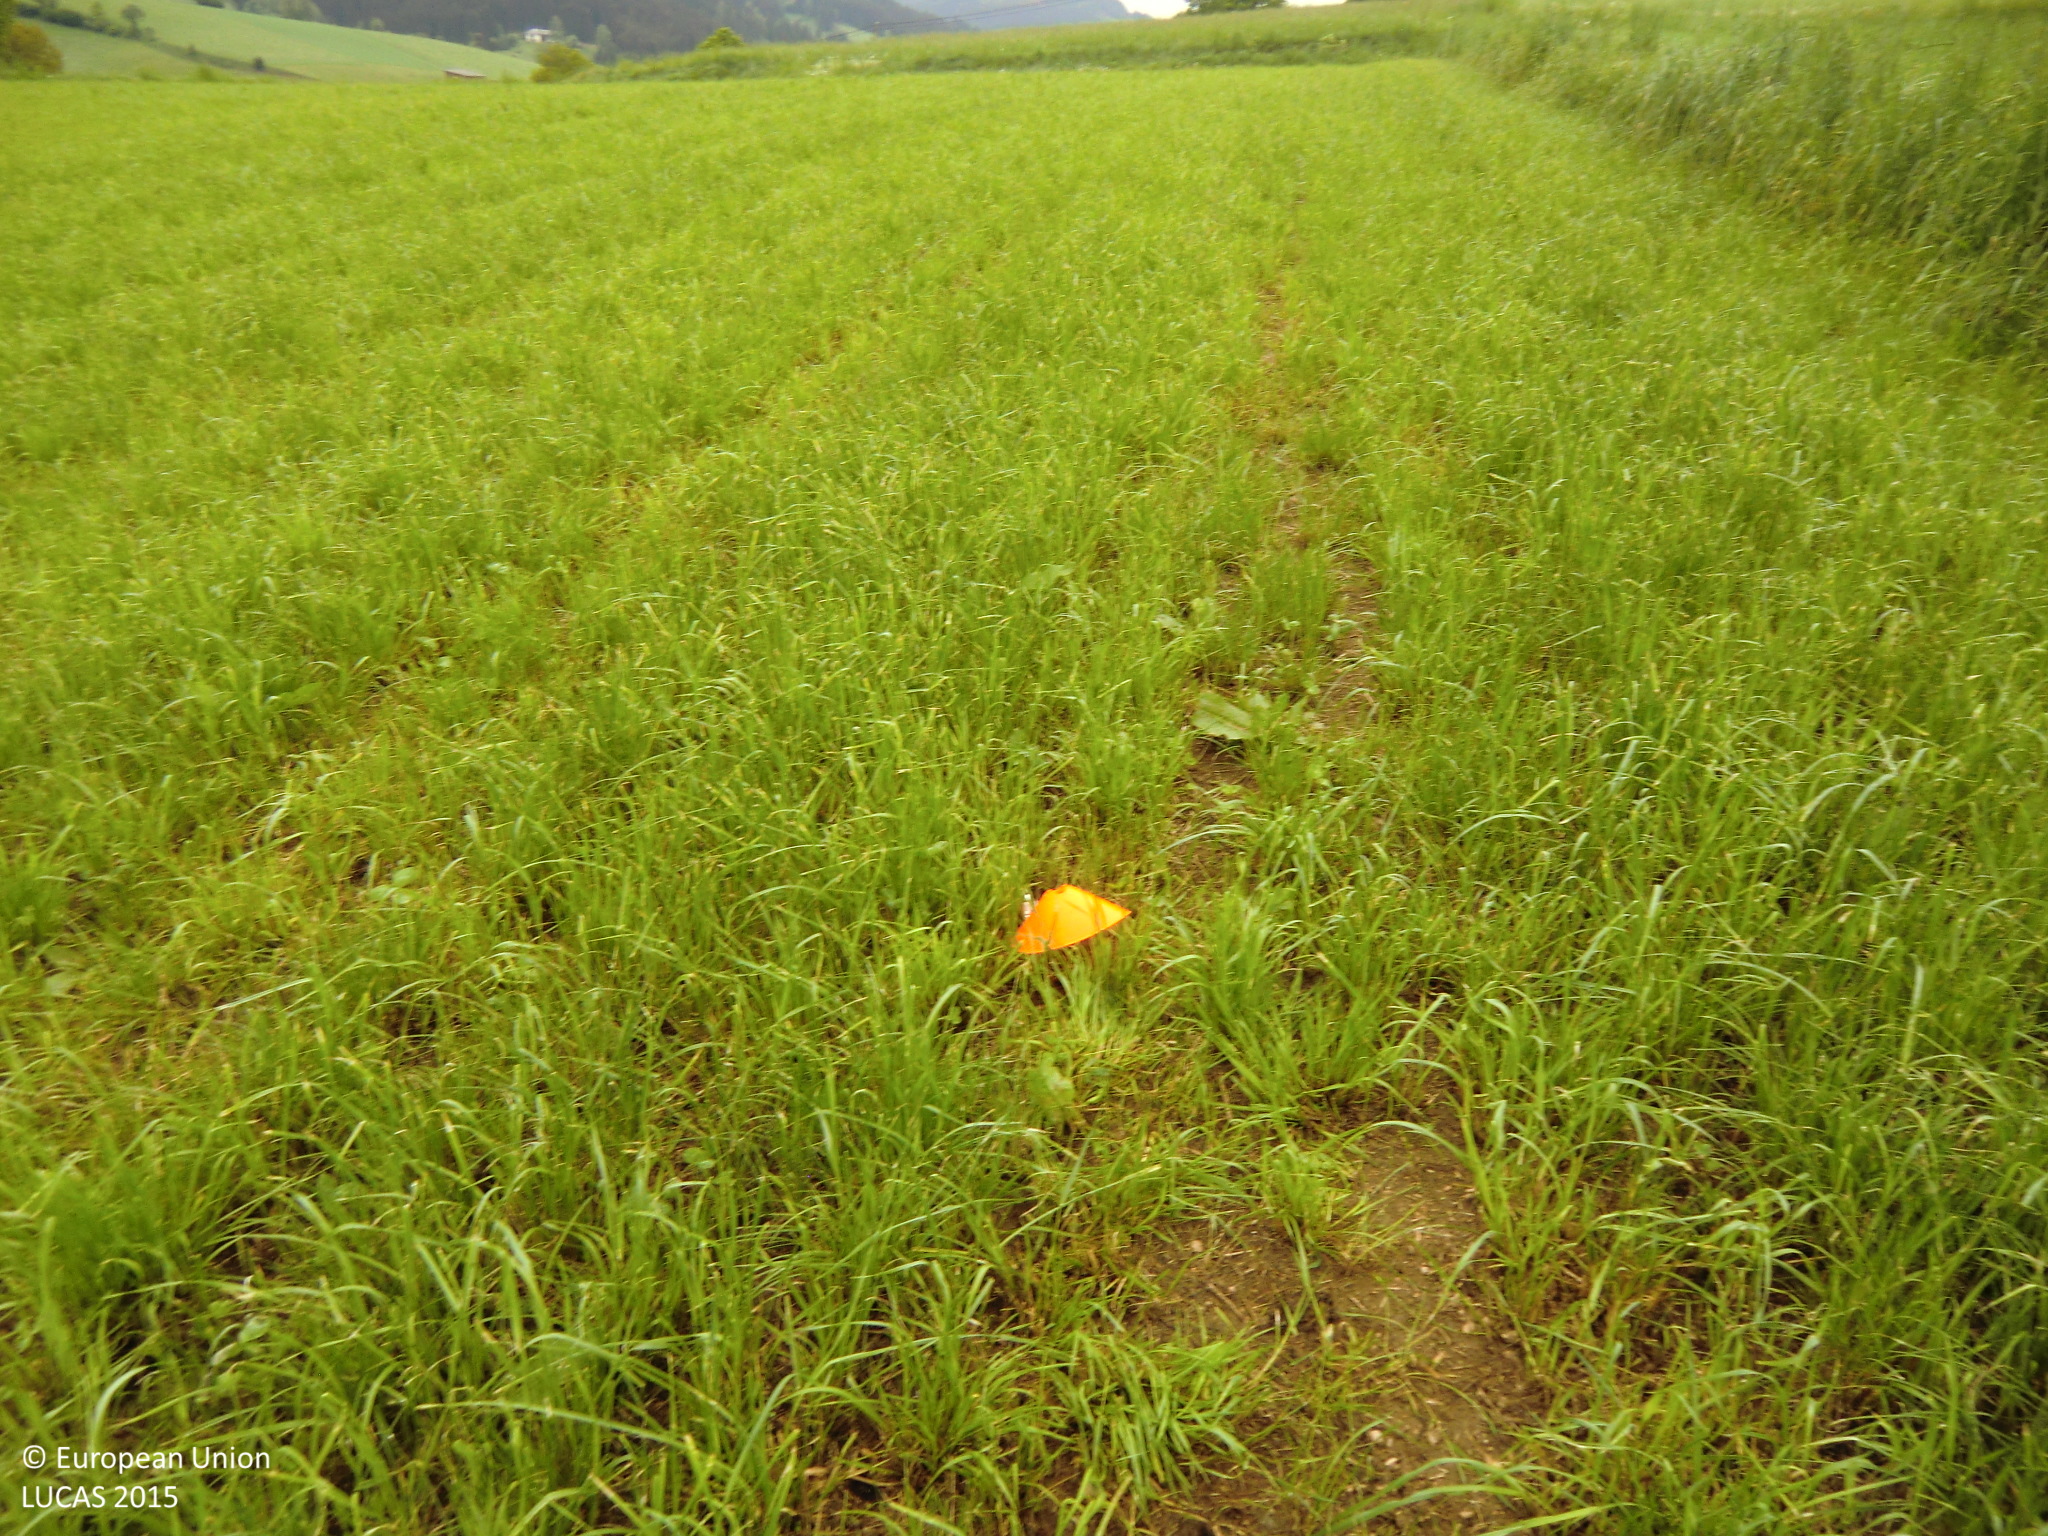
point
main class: Grassland
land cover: Grassland without tree/shrub cover
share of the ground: > 75 %
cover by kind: herbaceous plants 90 %, unconsolidated bare surface 10 %
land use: Agriculture (excluding fallow land and kitchen gardens)
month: May
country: AT
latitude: 48.3885
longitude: 14.8221
